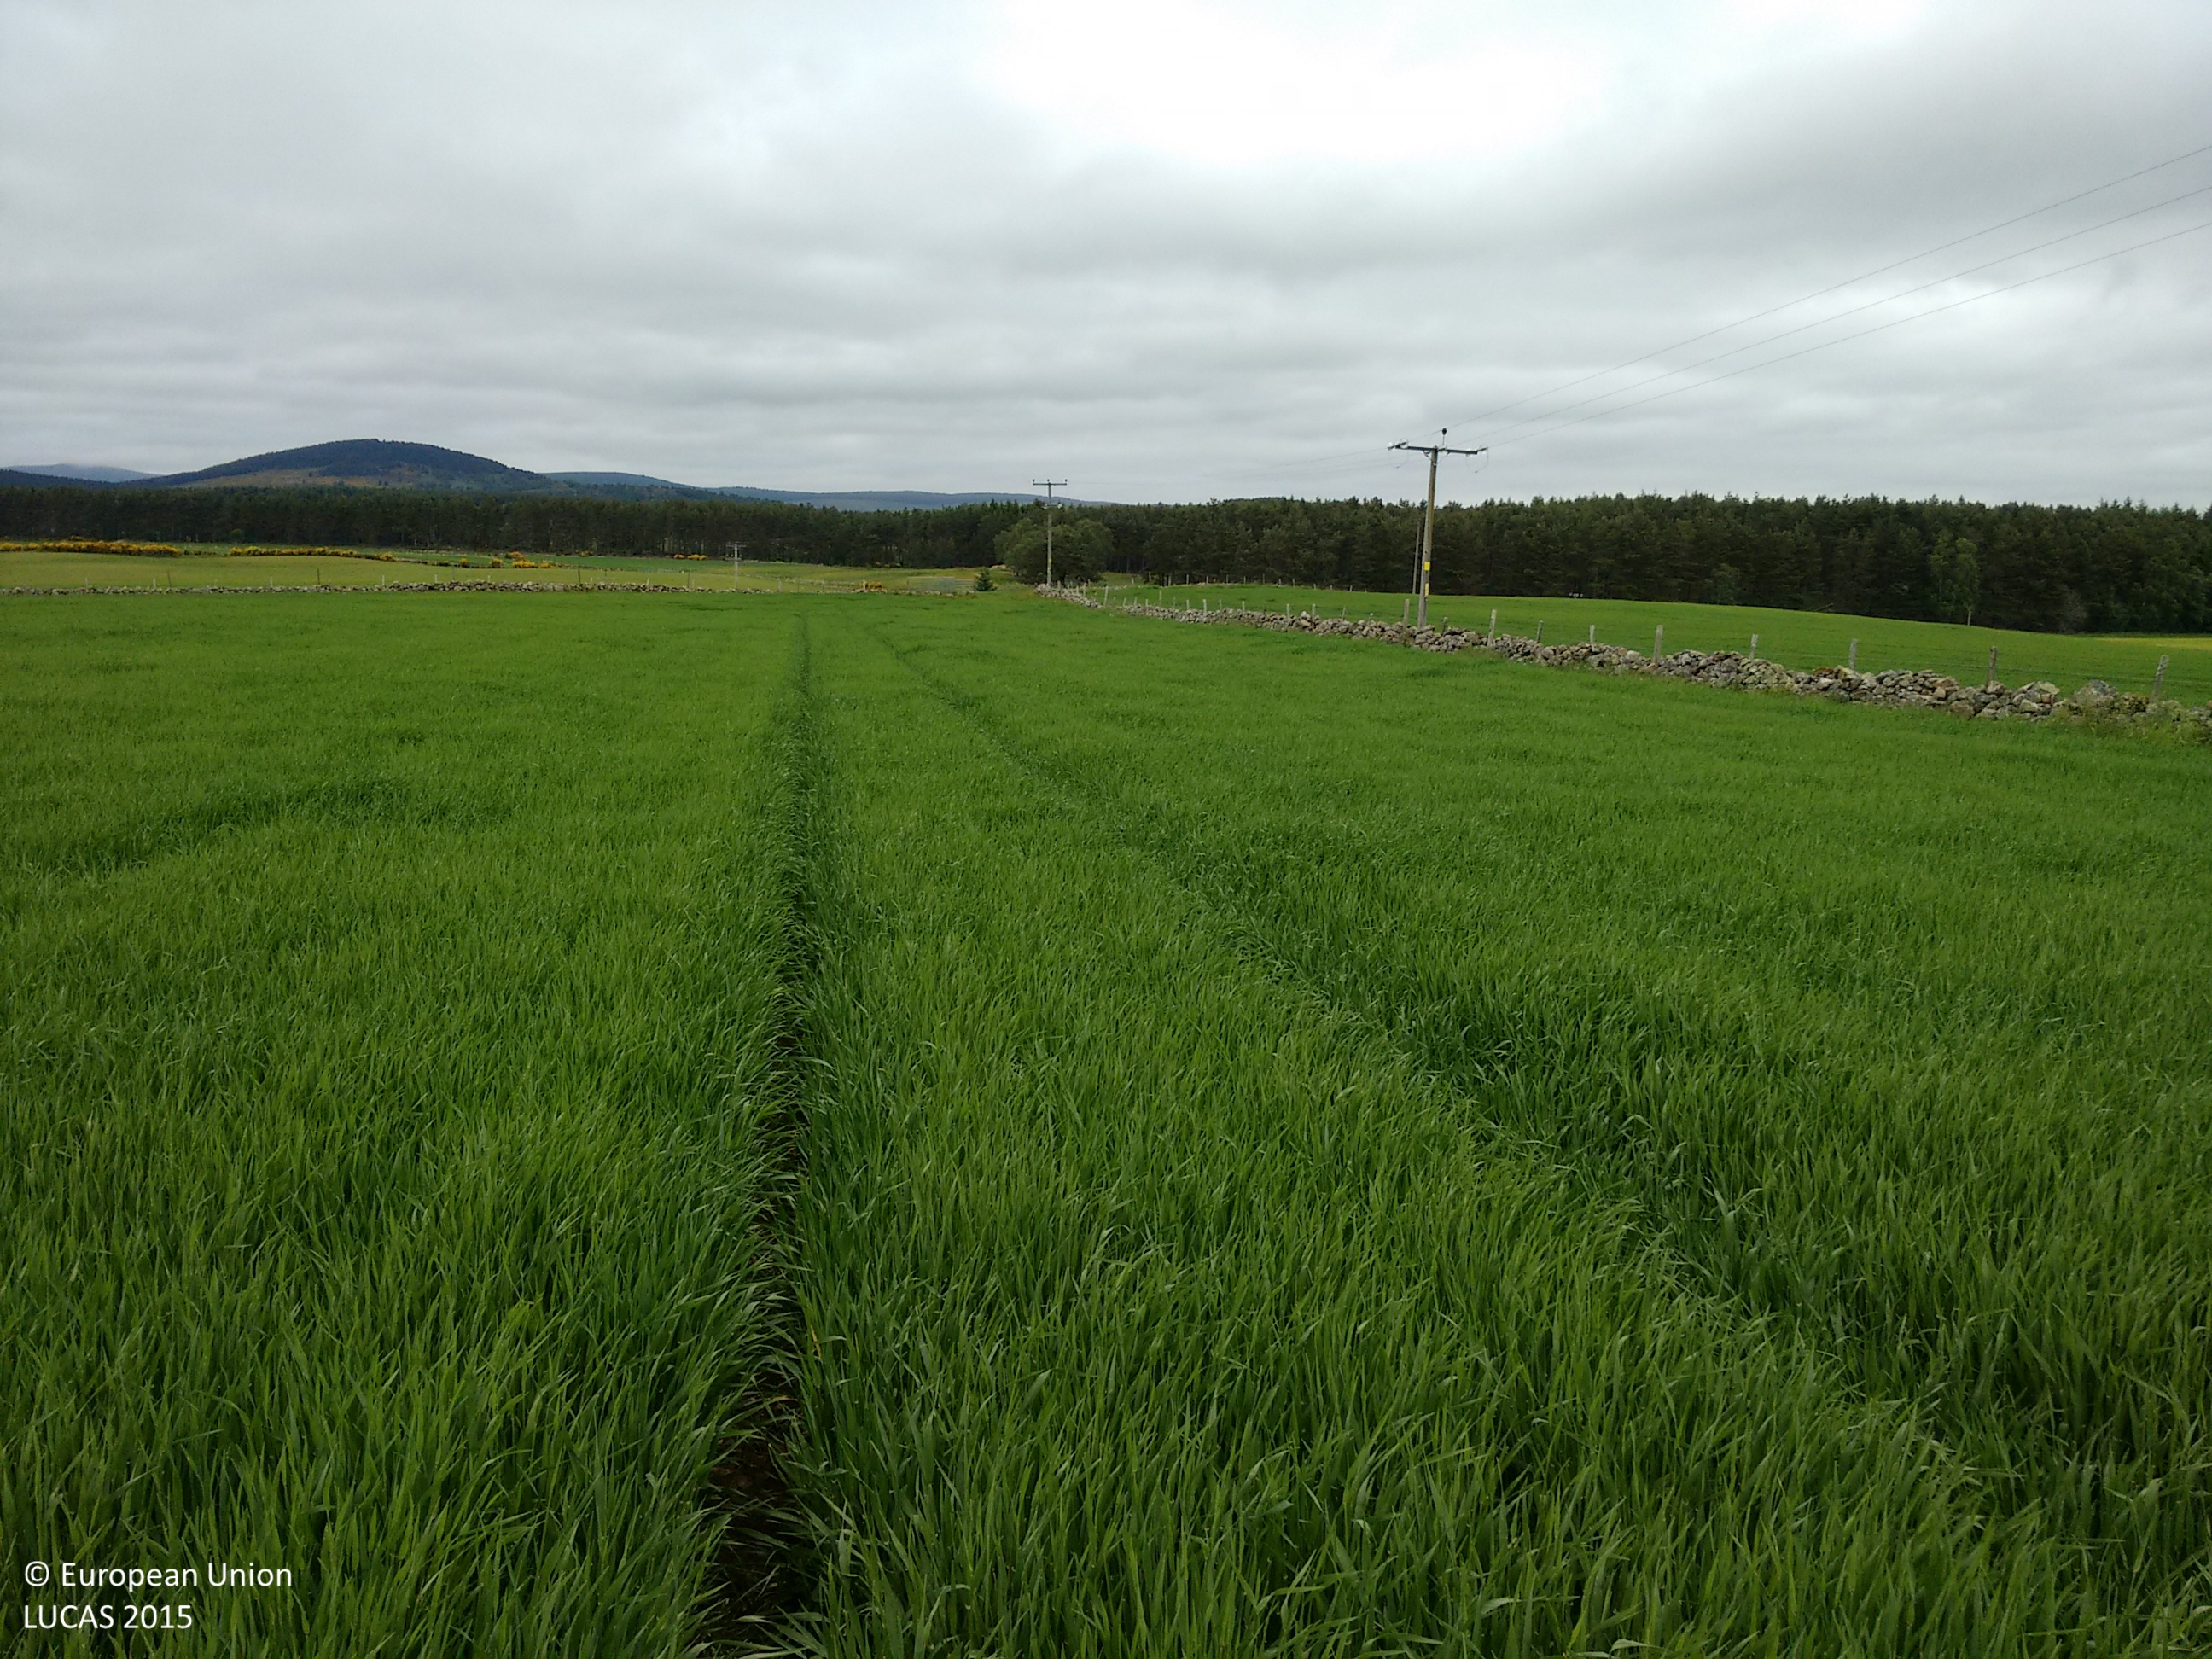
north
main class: Cropland
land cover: Barley
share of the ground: > 75 %
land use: Agriculture (excluding fallow land and kitchen gardens)
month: June
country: GB
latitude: 57.0628
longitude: -2.7400
